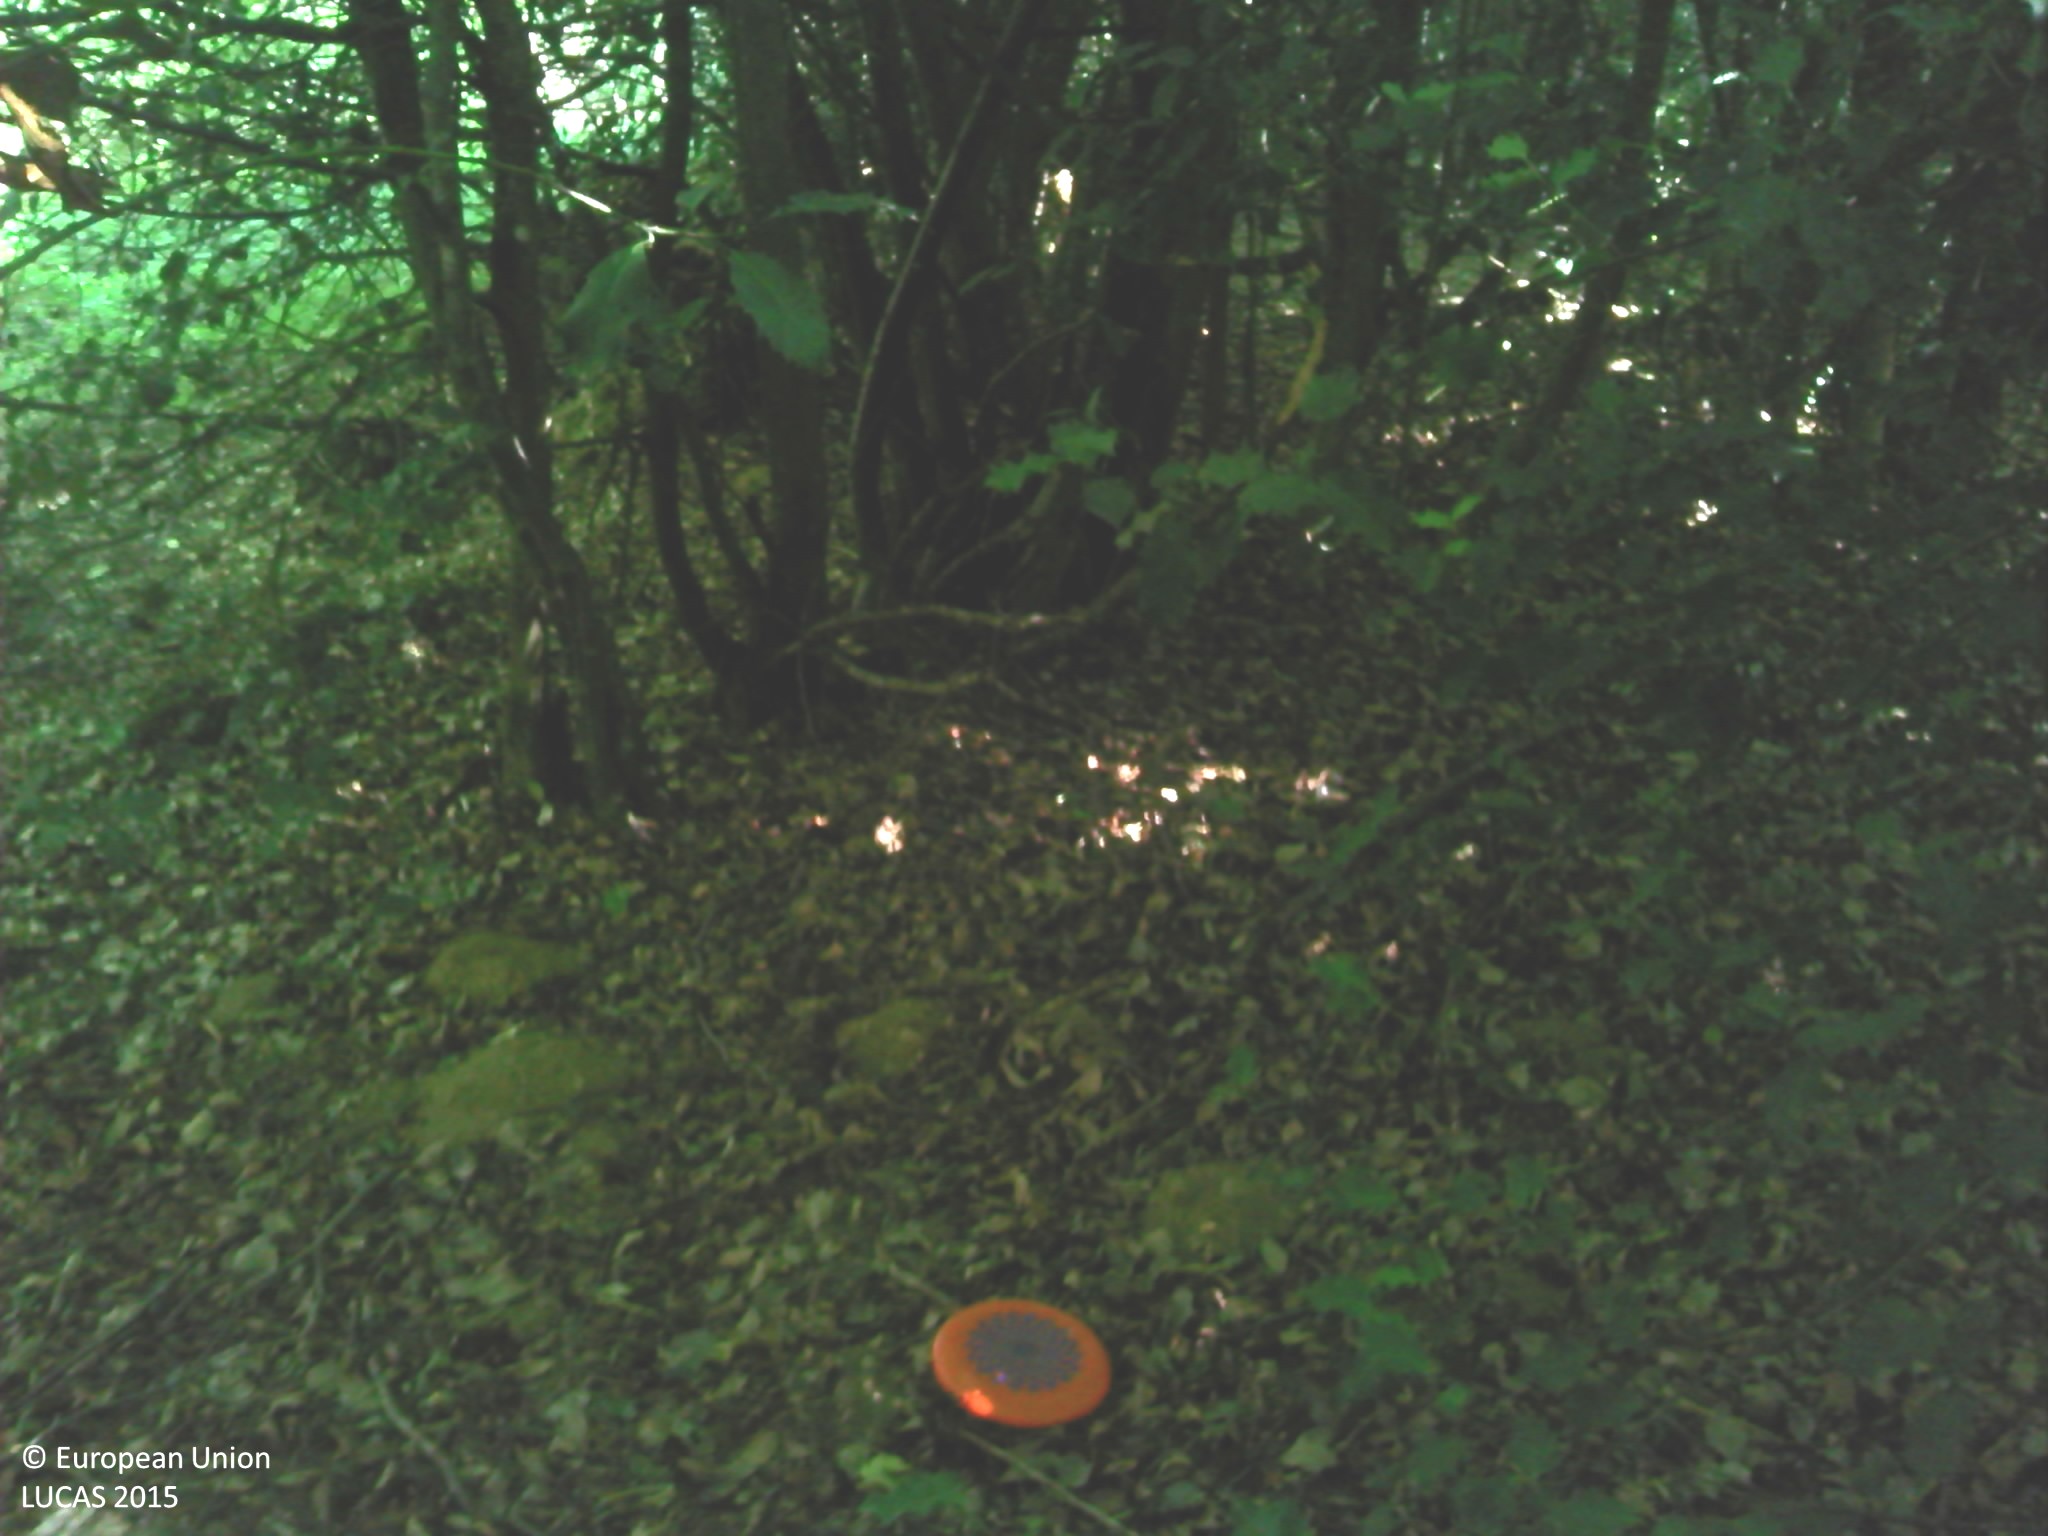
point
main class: Woodland
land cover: Broadleaved woodland
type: beech forest
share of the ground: > 75 %
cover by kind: broadleaved forest trees 75 %, consolidated bare surface 15 %, coniferous forest trees 5 %, herbaceous plants 5 %
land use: Forestry
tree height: > 5 m
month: July
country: FR
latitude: 45.4475
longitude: 5.1588
